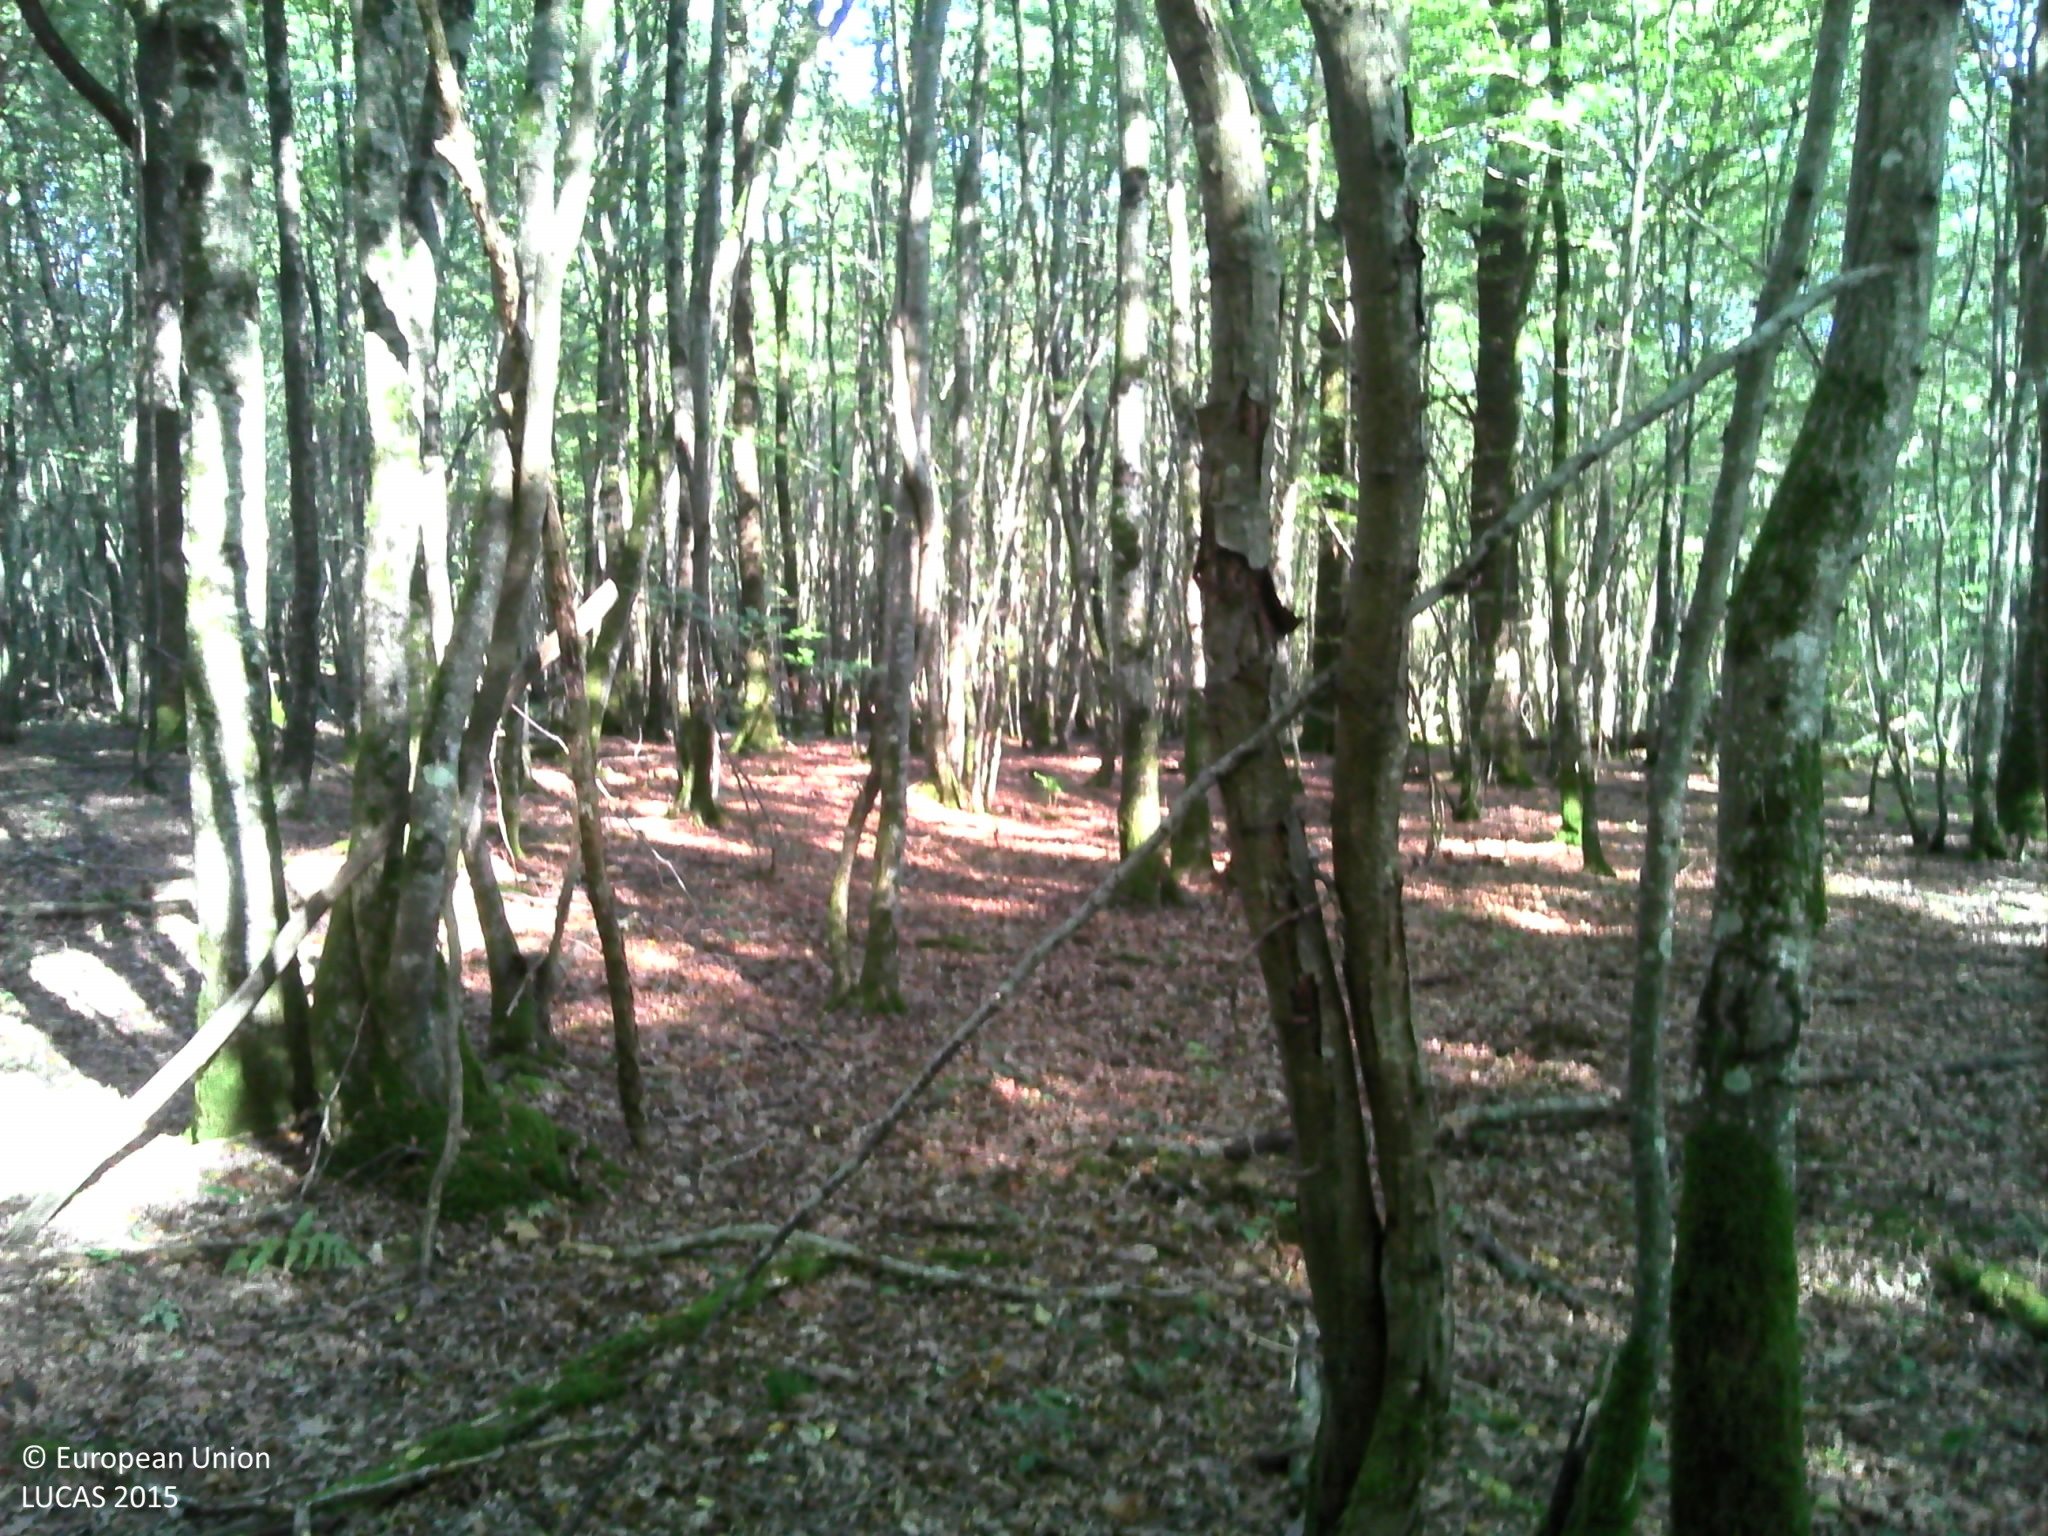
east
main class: Woodland
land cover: Broadleaved woodland
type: mesophytic deciduous forest
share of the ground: > 75 %
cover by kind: broadleaved forest trees 90 %, herbaceous plants 5 %, lichens and mosses 5 %
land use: Forestry
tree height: > 5 m
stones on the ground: < 10 %
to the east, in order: Broadleaved woodland
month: September
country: FR
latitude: 48.1423
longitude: 3.8541
